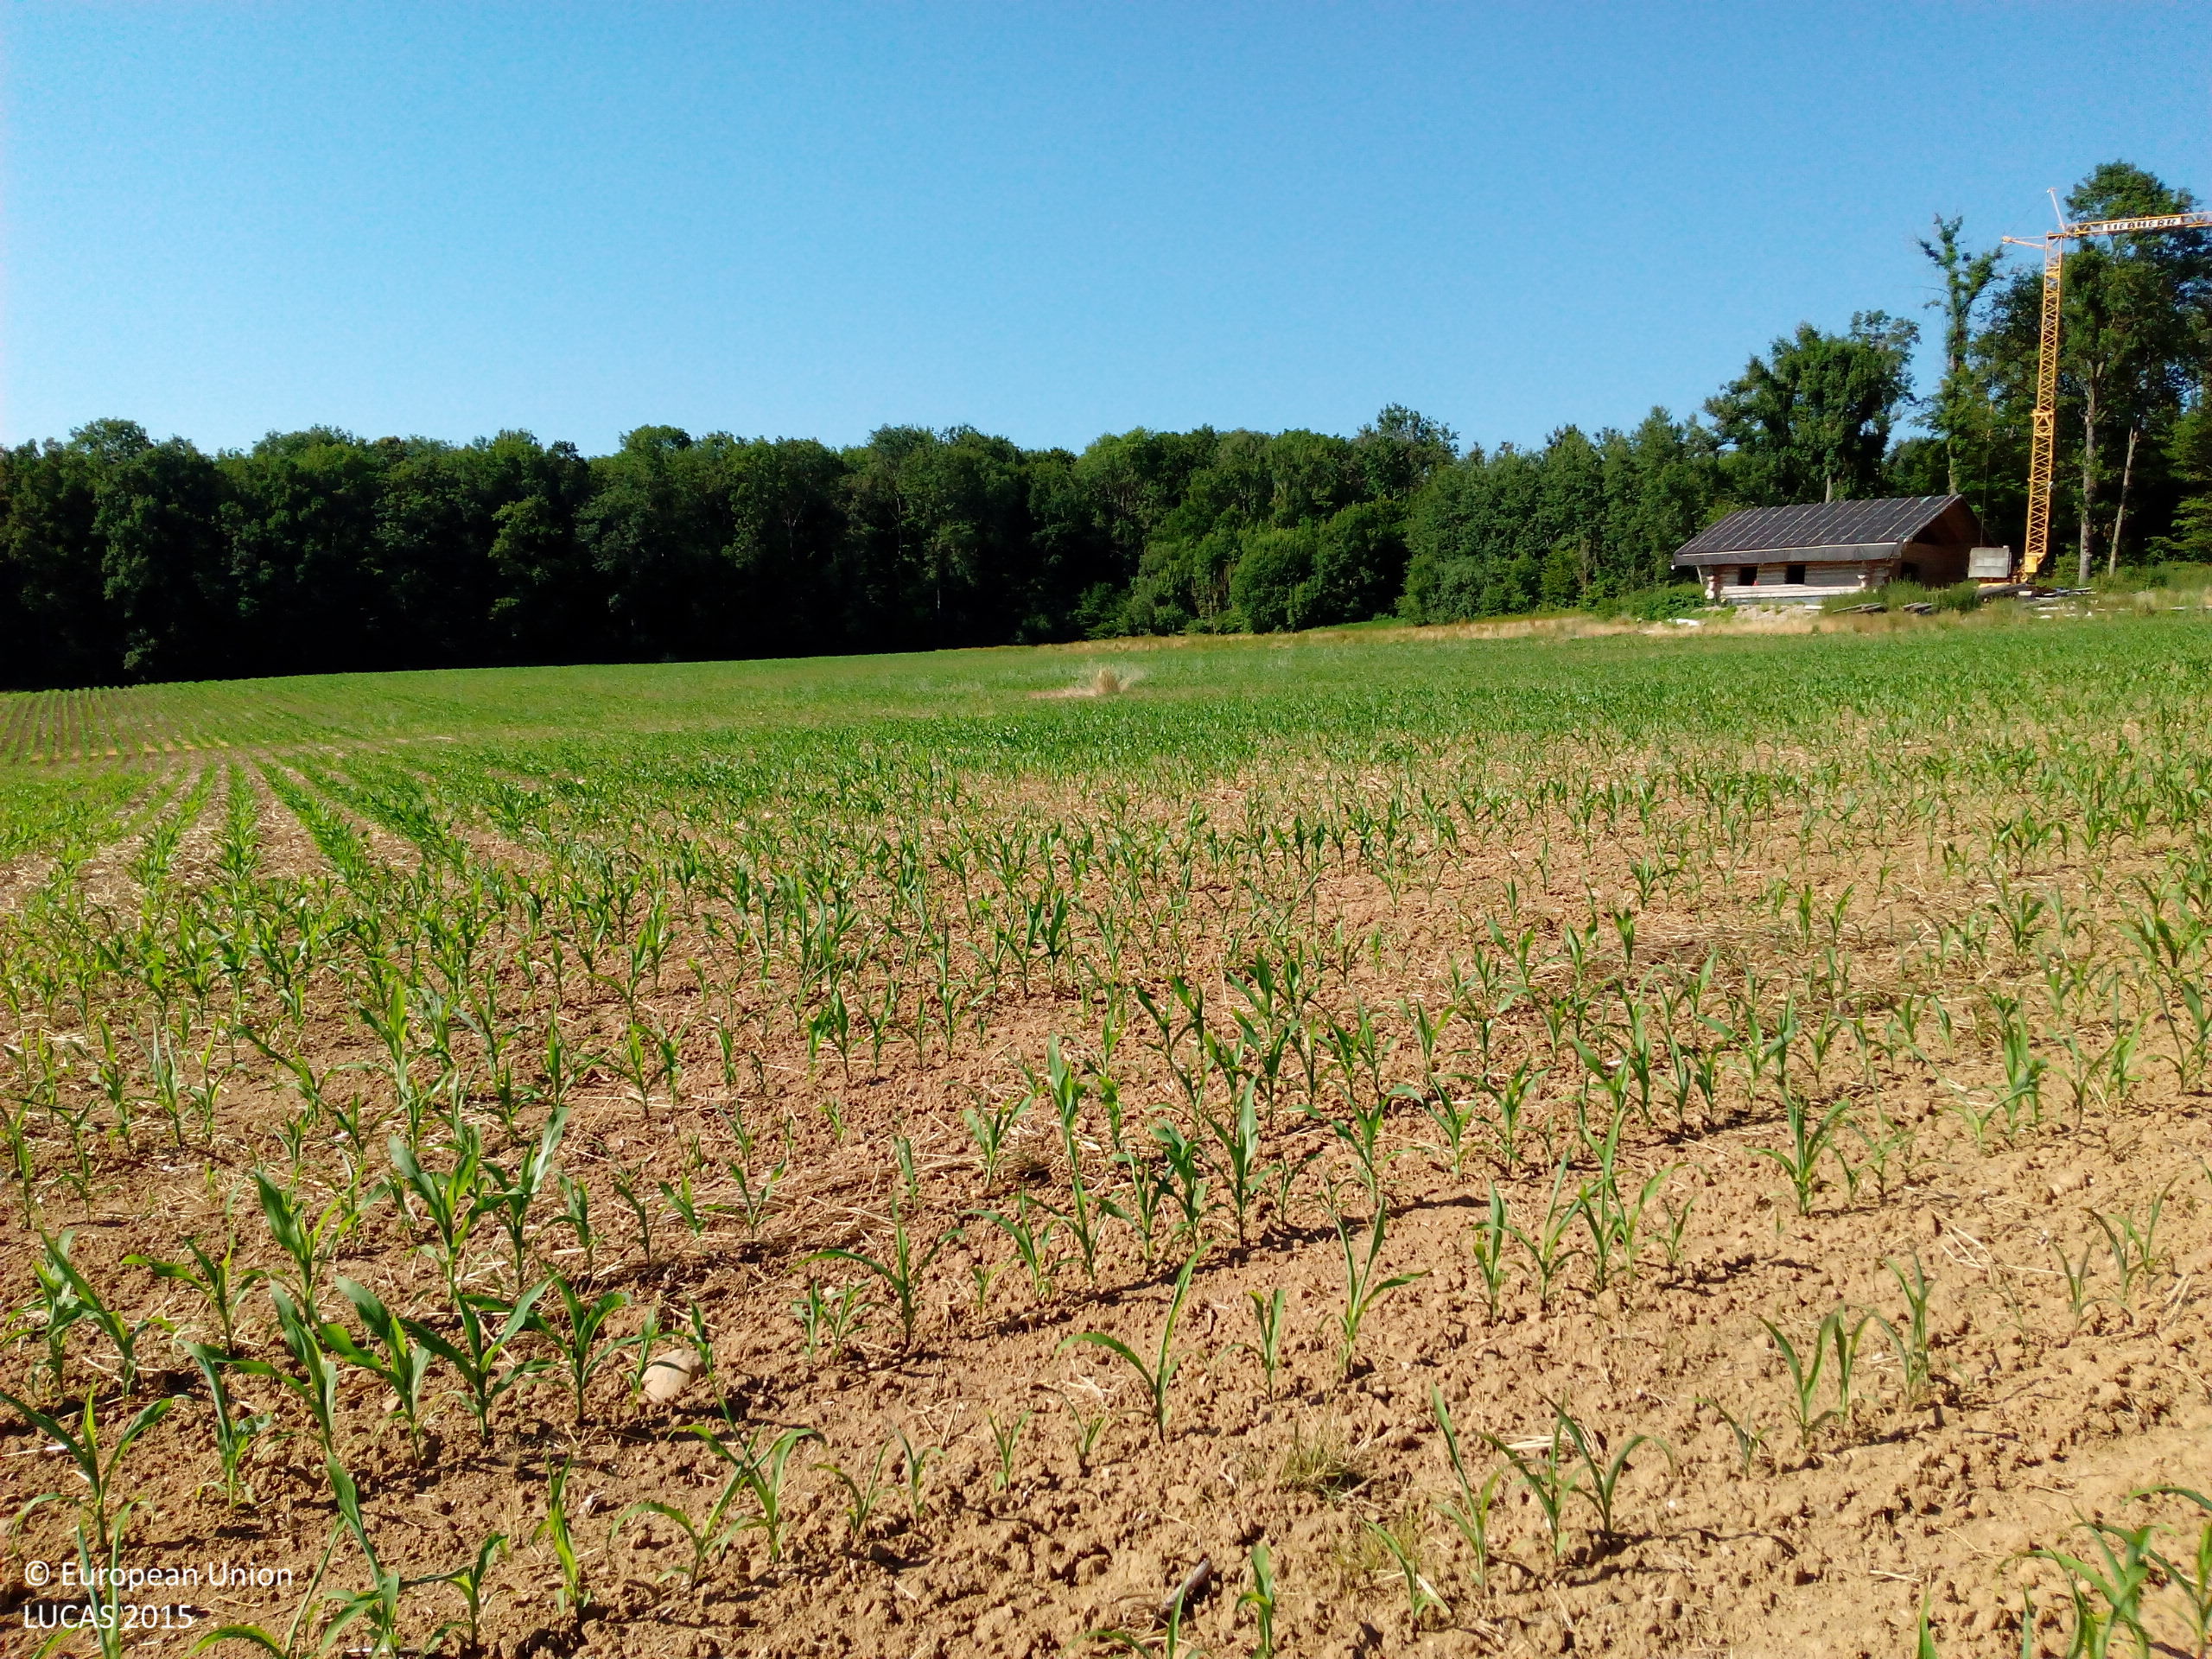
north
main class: Cropland
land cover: Maize
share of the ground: 25 - 50 %
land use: Agriculture (excluding fallow land and kitchen gardens)
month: July
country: DE
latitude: 47.7843
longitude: 8.7329
